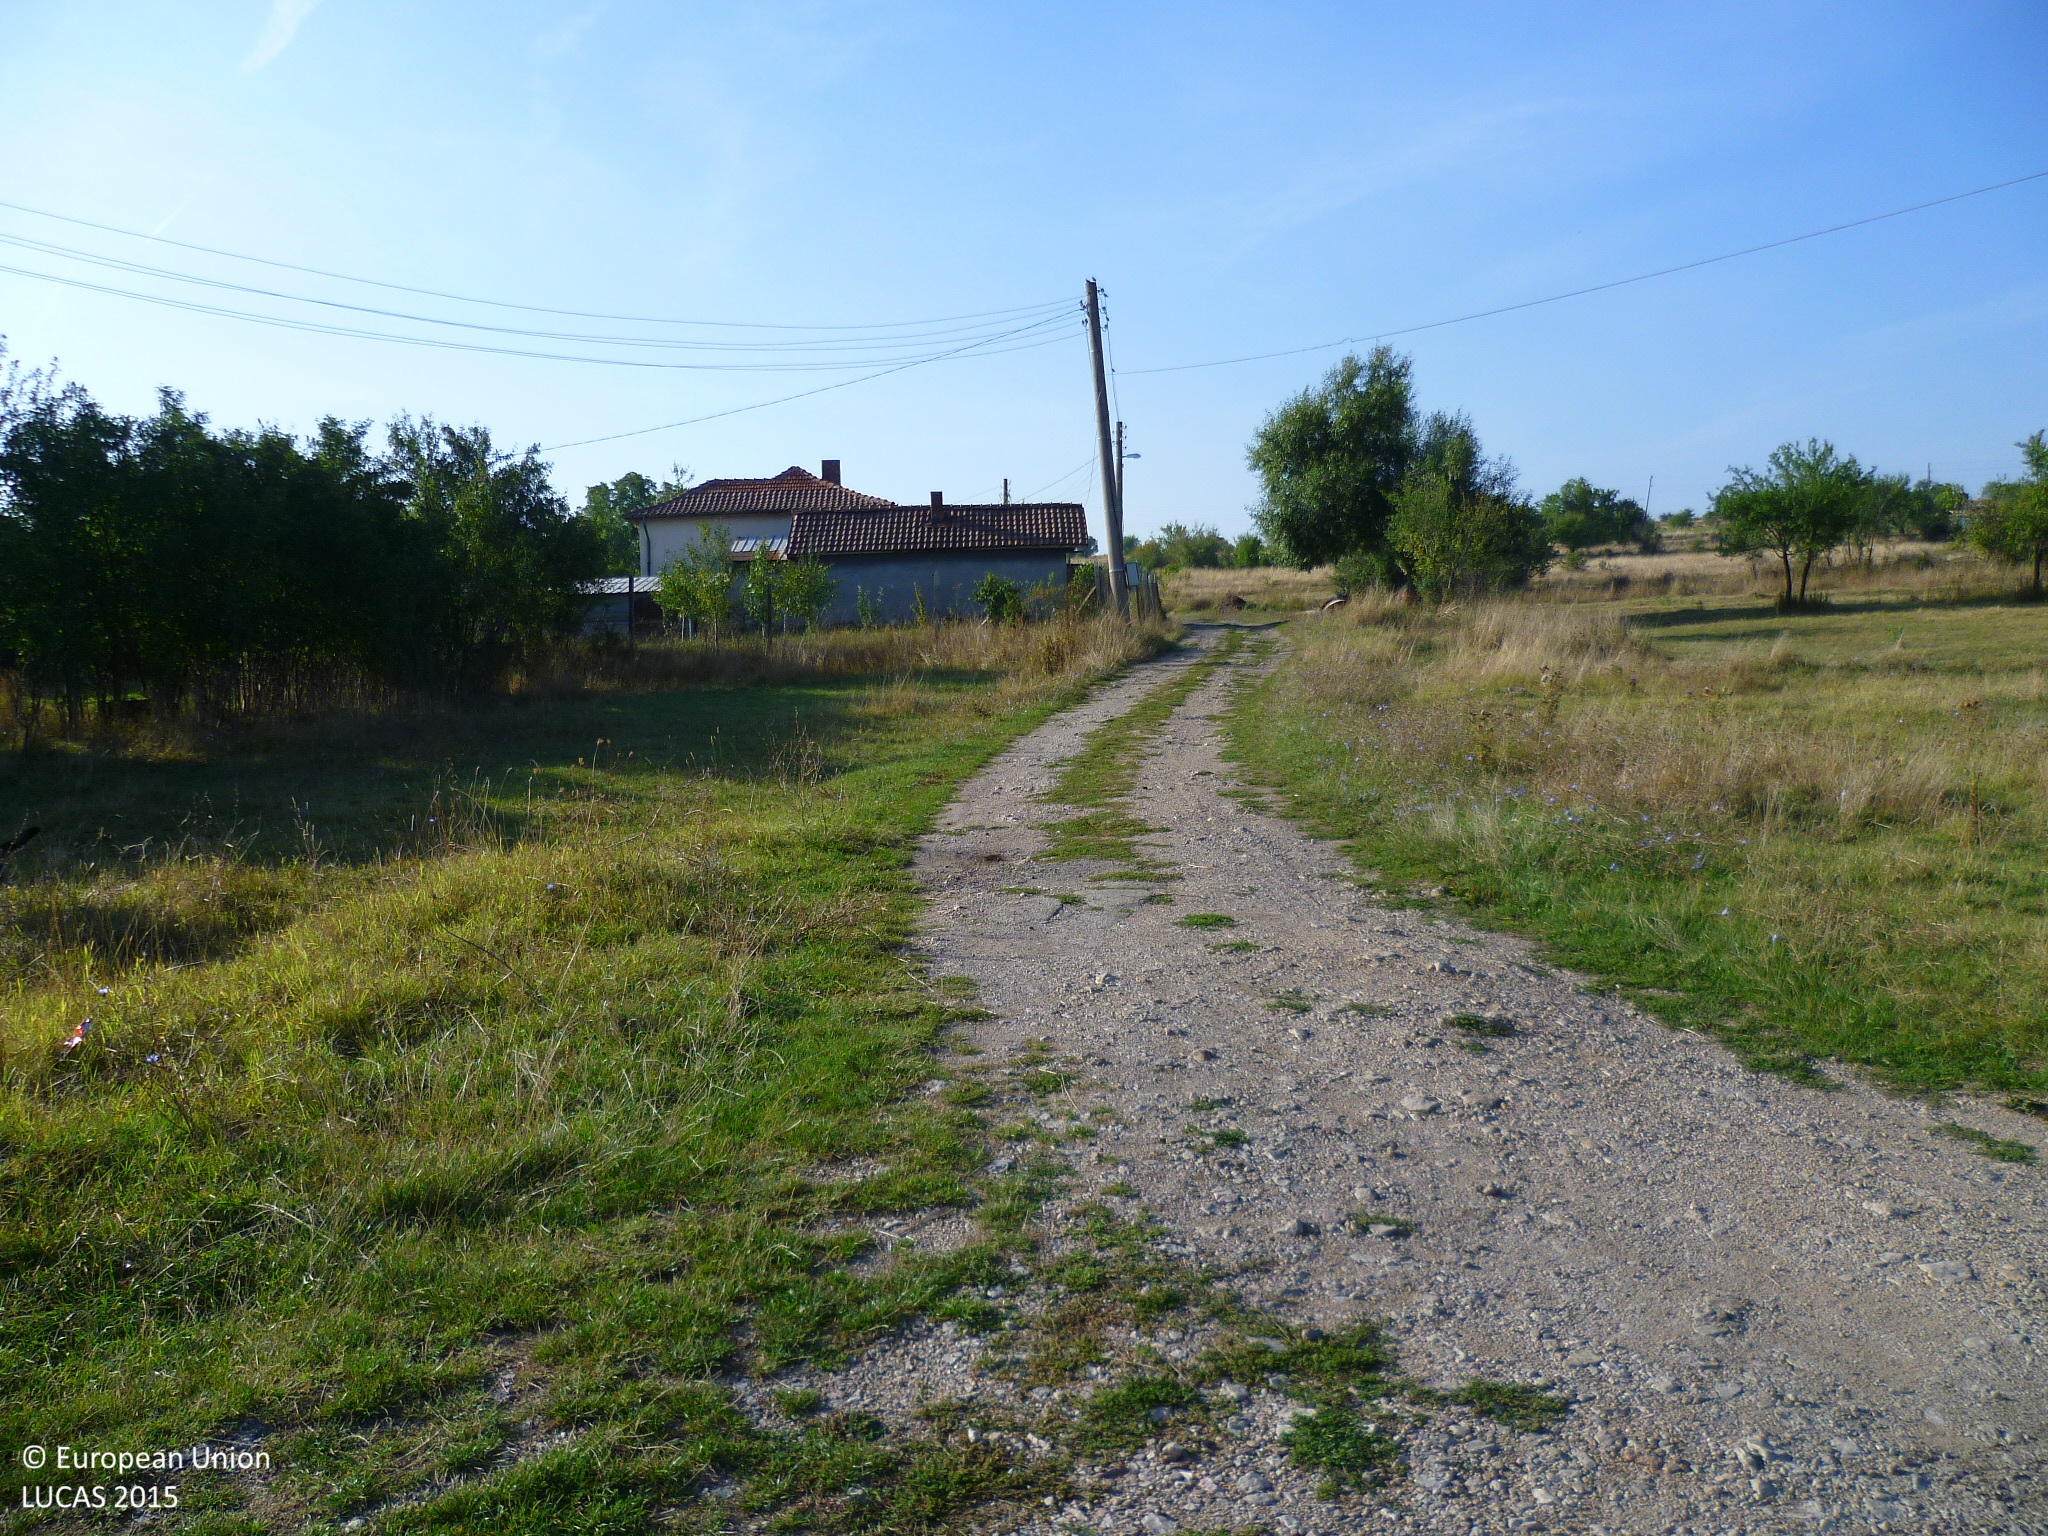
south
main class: Grassland
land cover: Grassland without tree/shrub cover
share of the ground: > 75 %
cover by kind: herbaceous plants 90 %, unconsolidated bare surface 10 %
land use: Agriculture (excluding fallow land and kitchen gardens)
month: September
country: BG
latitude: 42.9171
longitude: 22.9304
